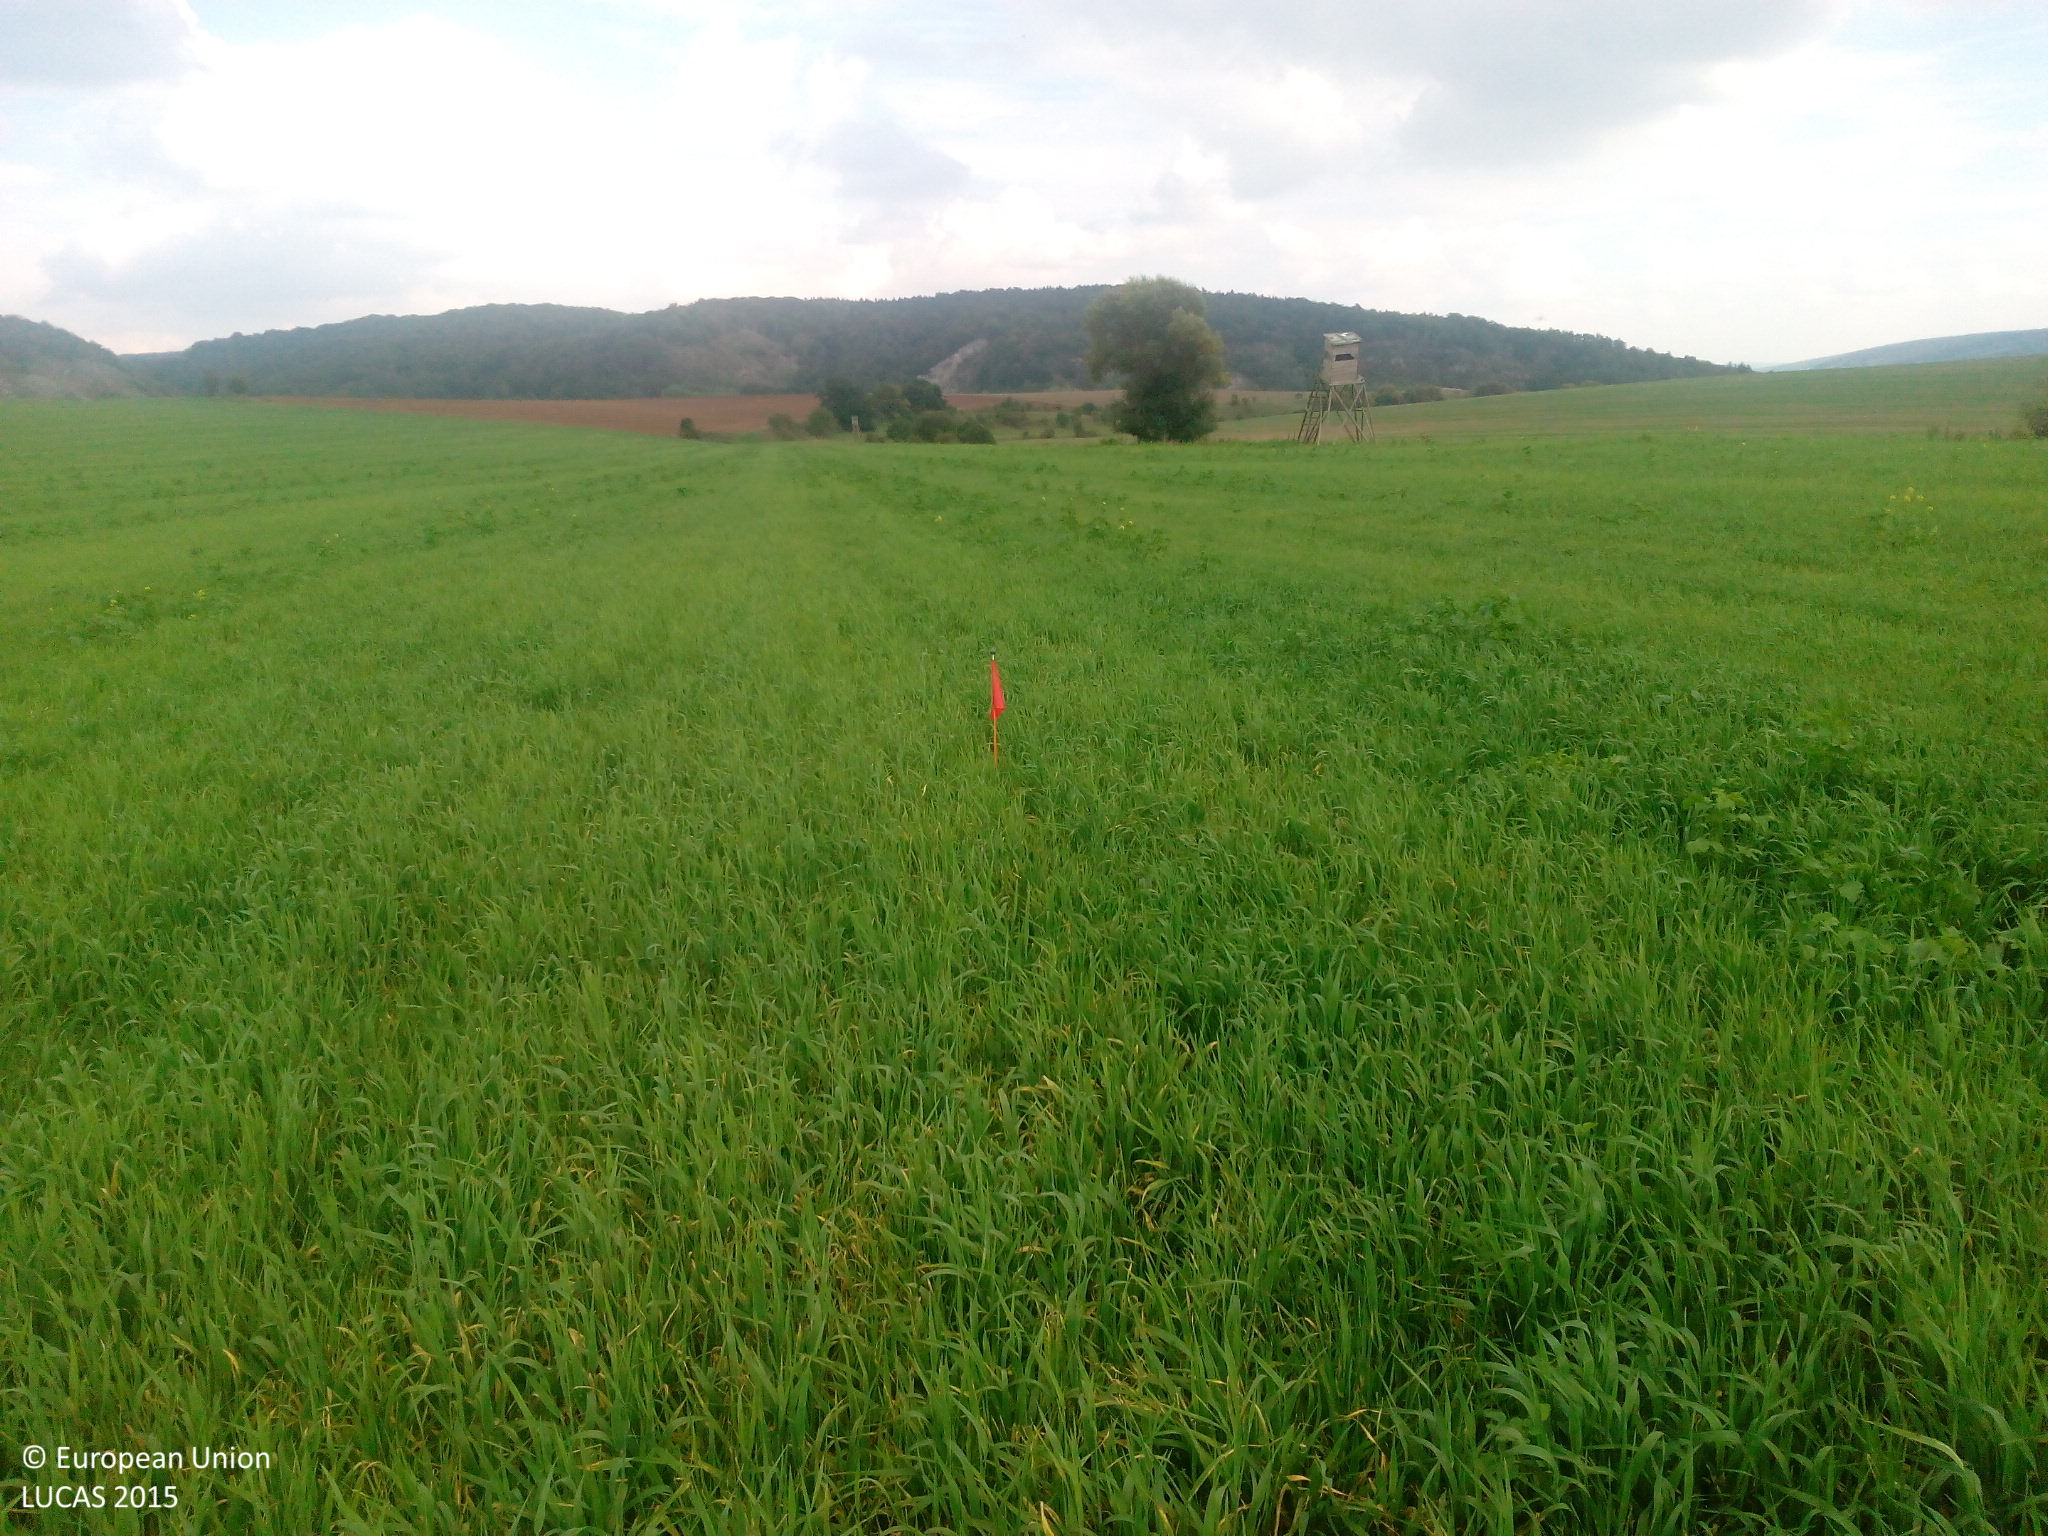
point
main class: Cropland
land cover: Temporary grasslands
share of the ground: > 75 %
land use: Agriculture (excluding fallow land and kitchen gardens)
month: September
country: DE
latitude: 51.3844
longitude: 11.0199
